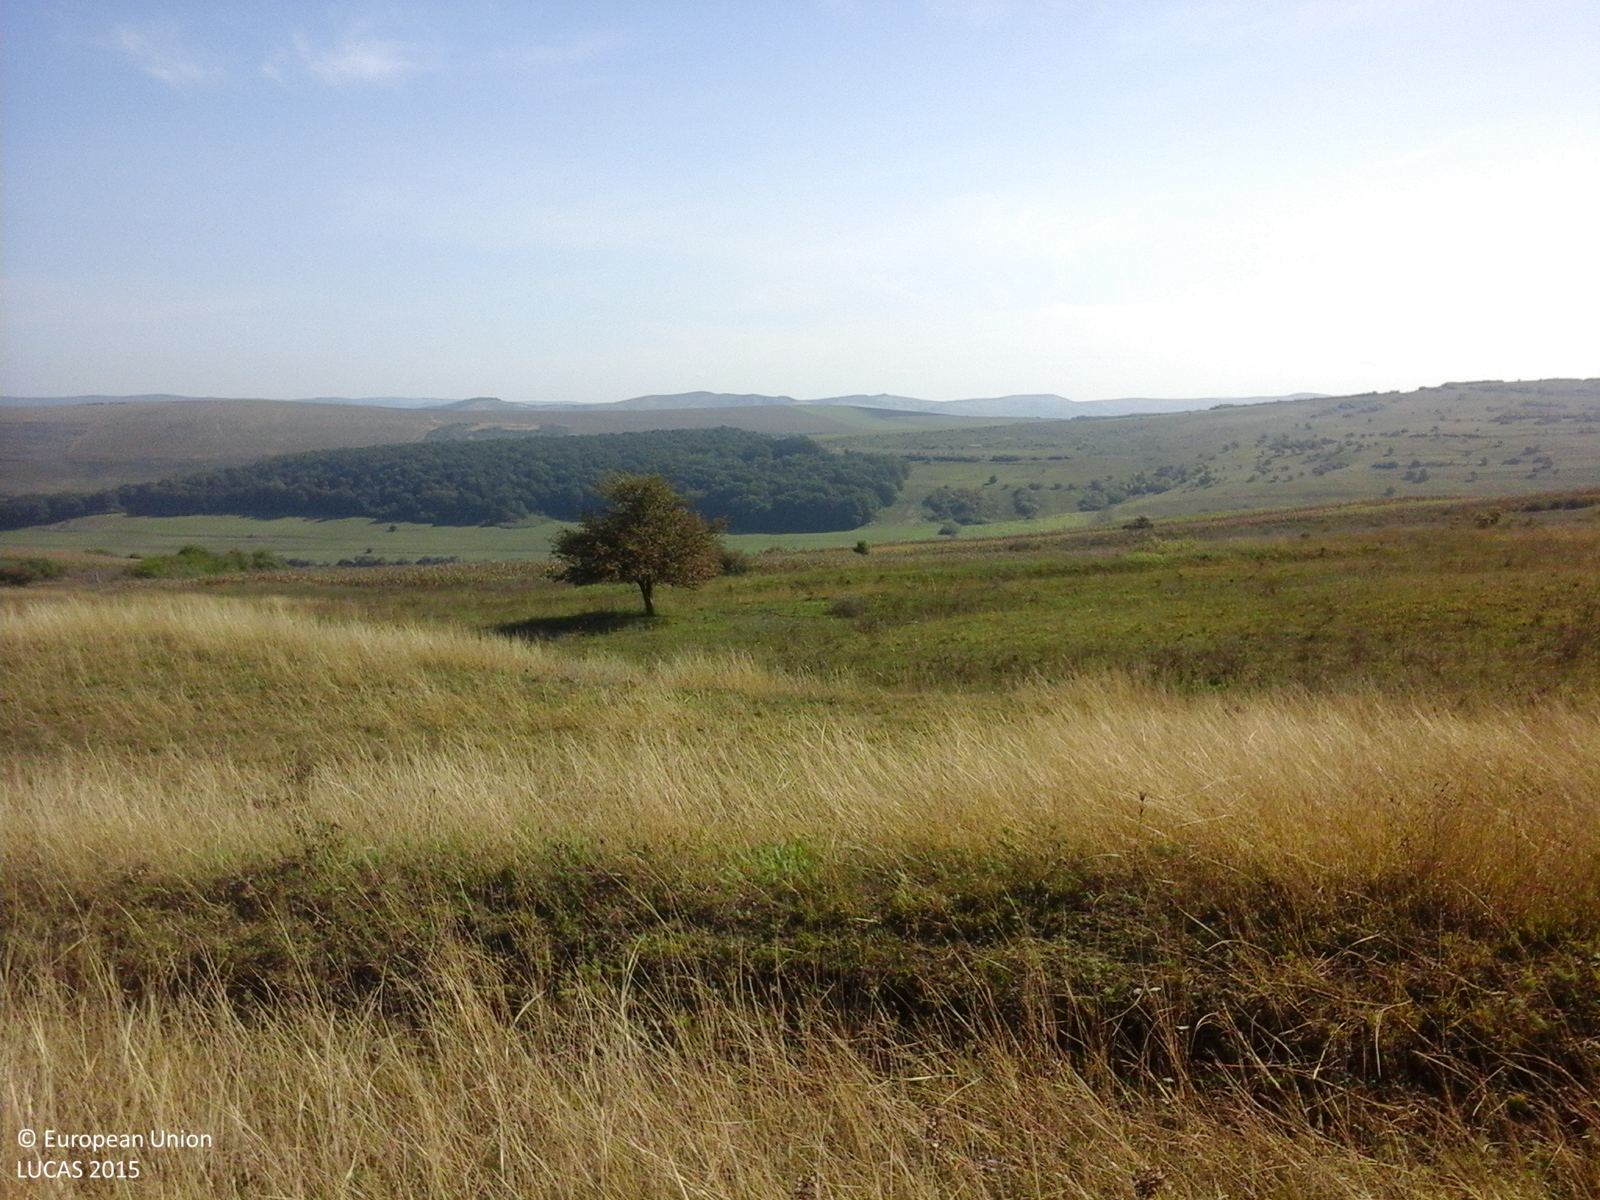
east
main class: Grassland
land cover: Grassland without tree/shrub cover
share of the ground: > 75 %
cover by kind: herbaceous plants 100 %
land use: Agriculture (excluding fallow land and kitchen gardens)
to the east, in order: Grassland without tree/shrub cover; Maize; Grass margins; Tracks; Spontaneously vegetated surfaces
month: October
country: RO
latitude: 46.1346
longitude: 23.8833
